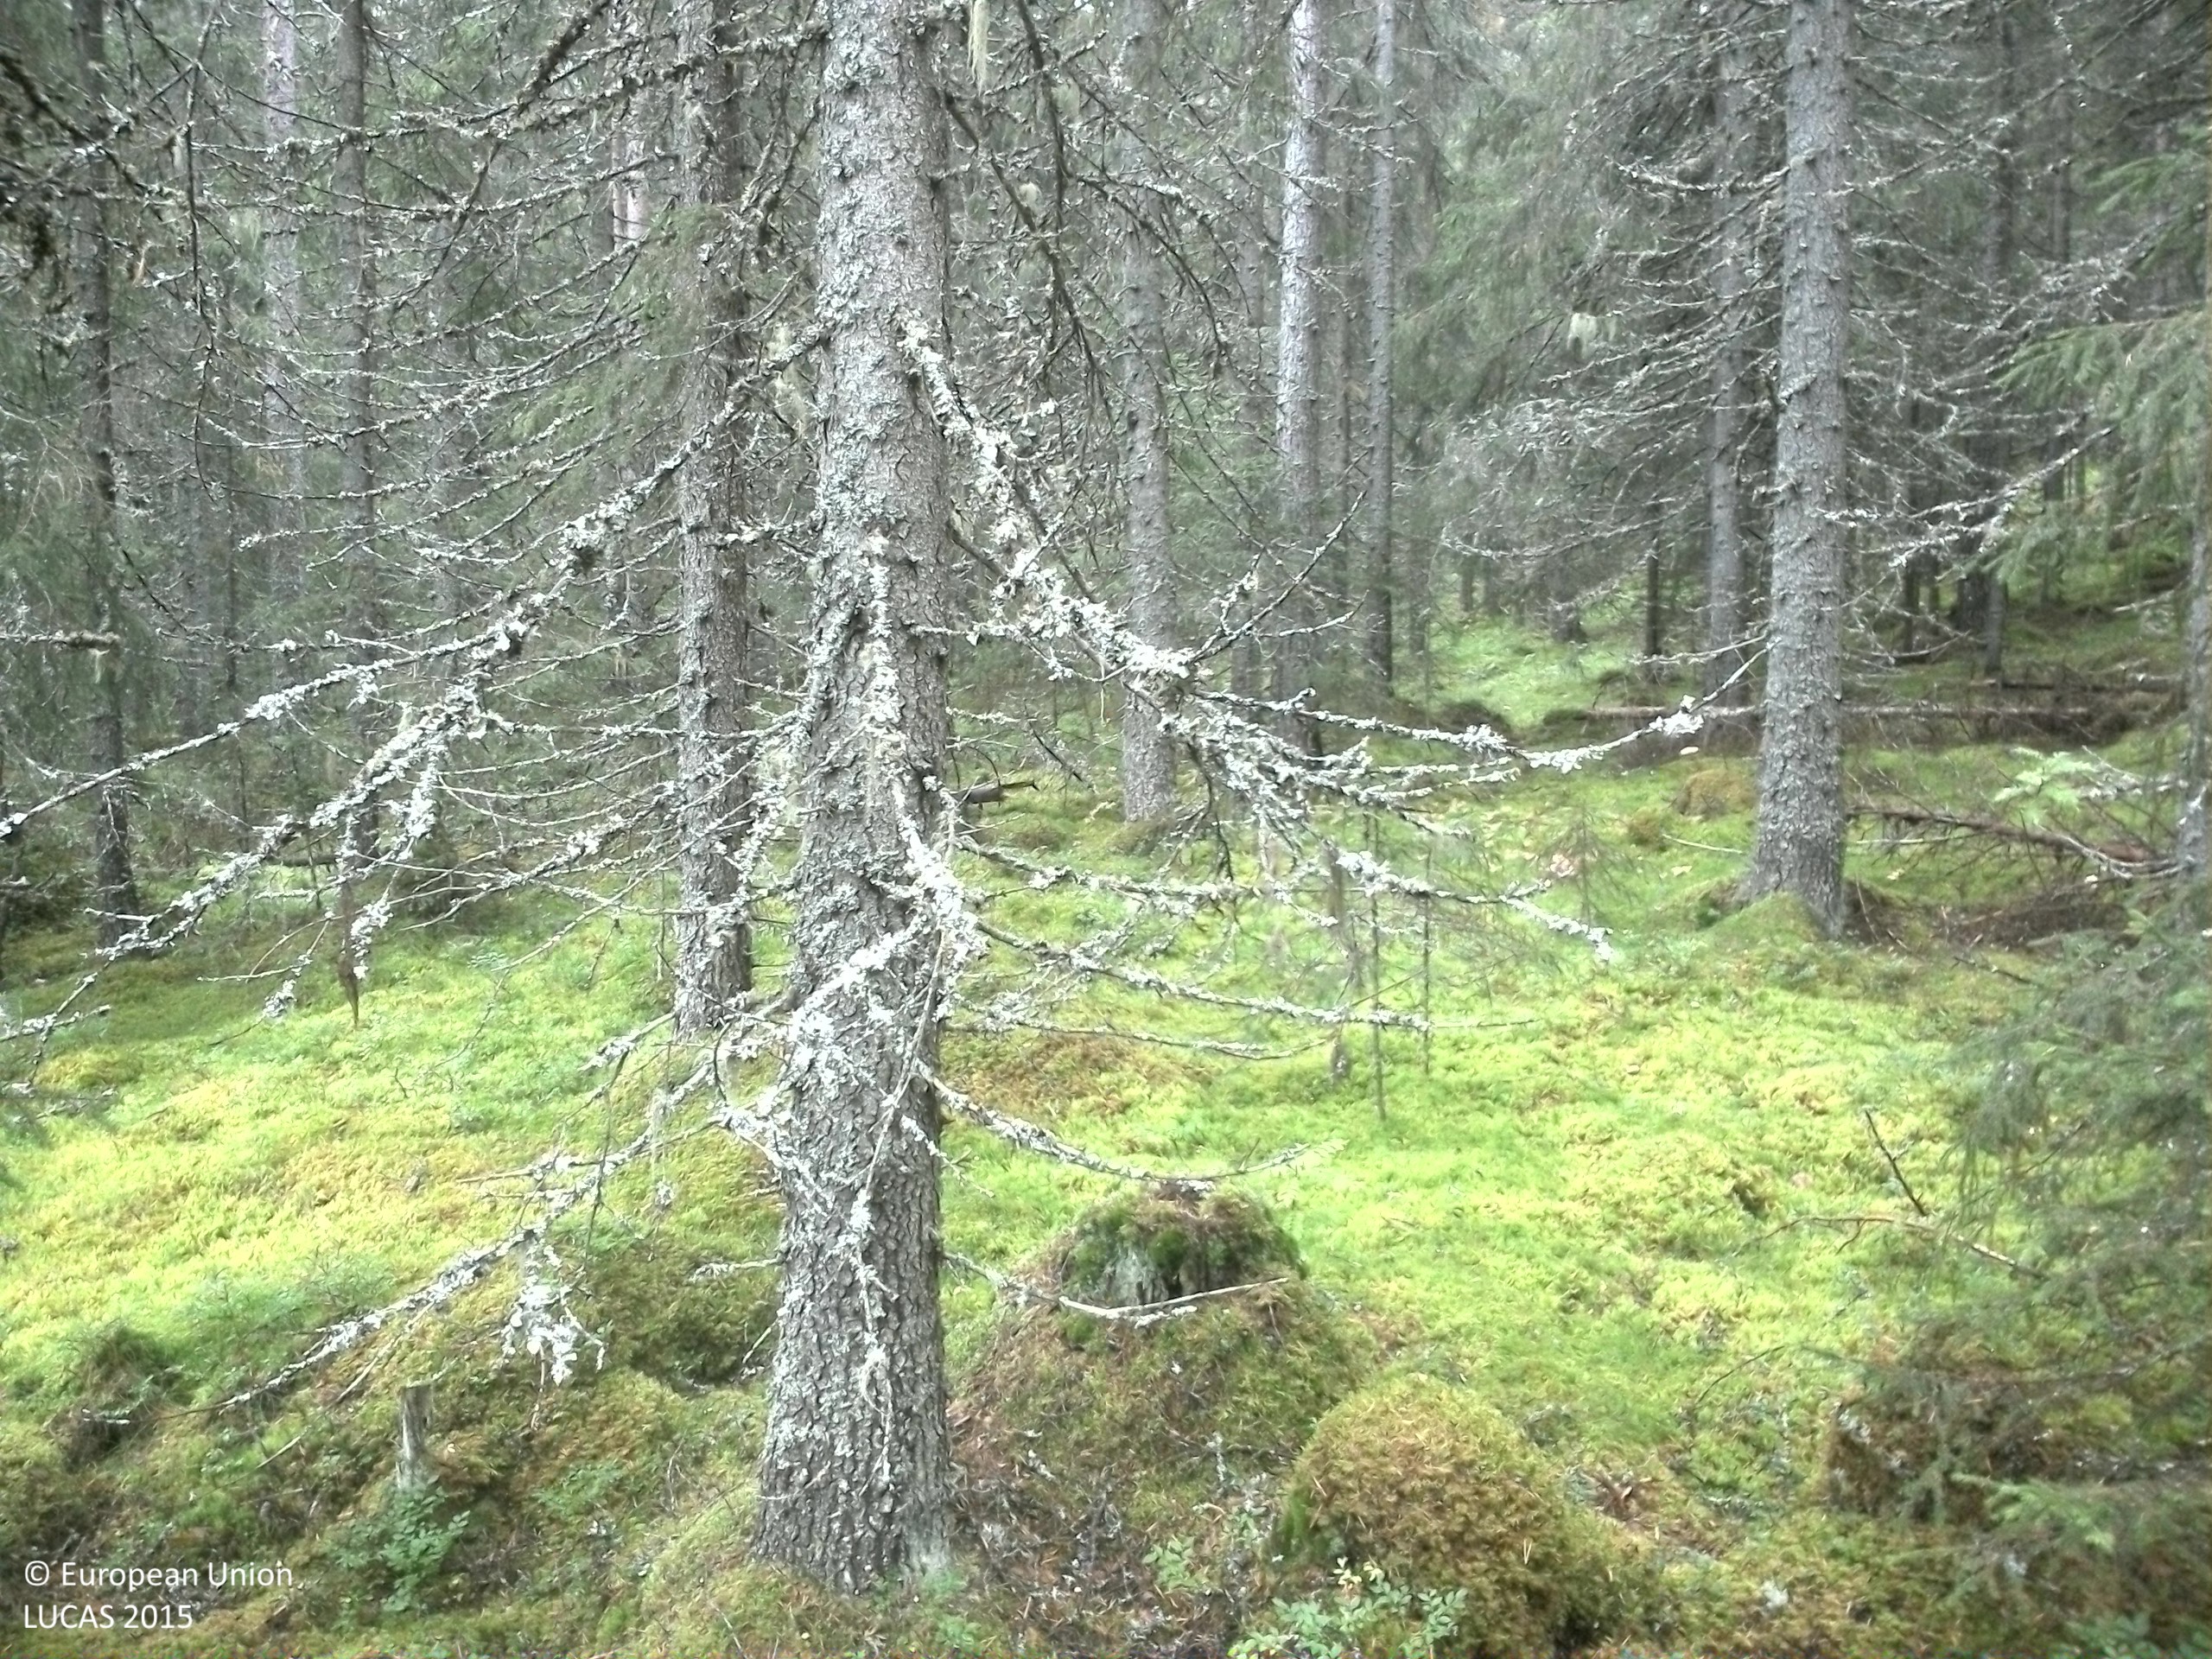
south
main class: Woodland
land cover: Spruce dominated coniferous woodland
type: boreal forest
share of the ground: 50 - 75 %
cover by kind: coniferous forest trees 60 %, shrubs 25 %, lichens and mosses 10 %, broadleaved forest trees 5 %
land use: Forestry
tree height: > 5 m
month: September
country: SE
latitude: 61.7101
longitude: 15.1848
